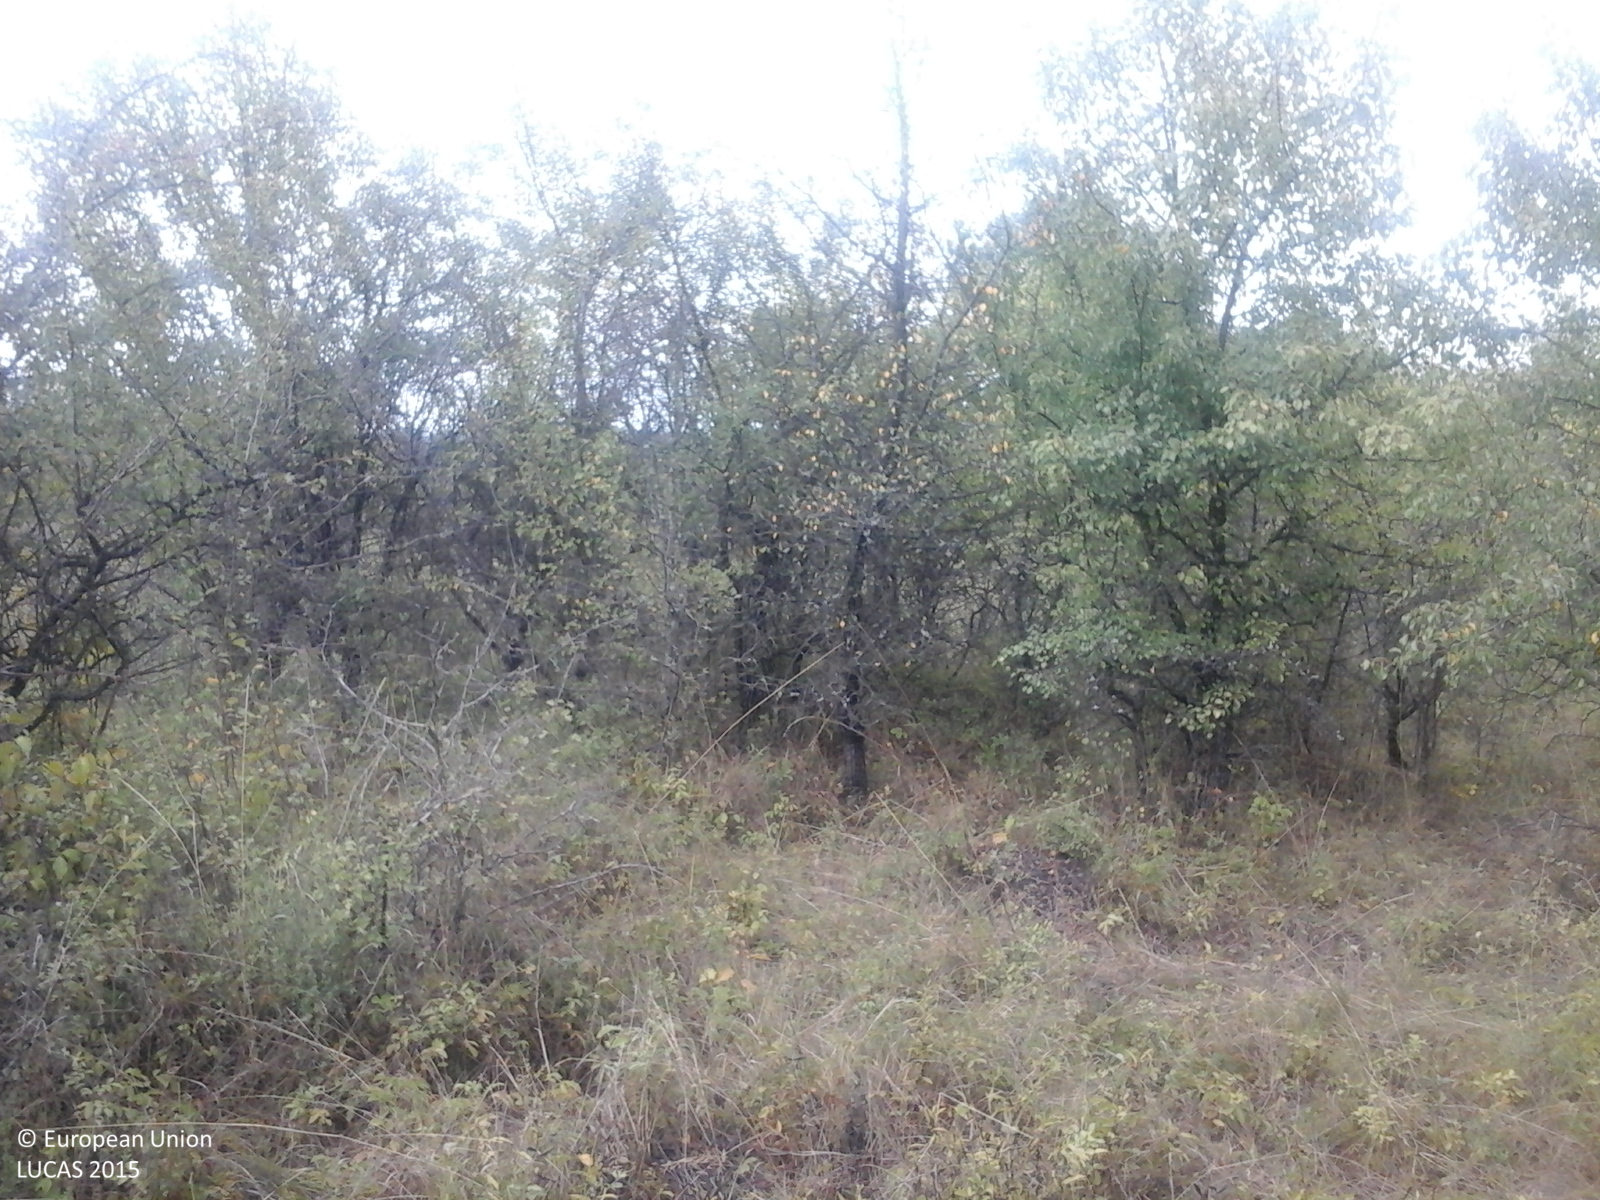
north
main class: Shrubland
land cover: Shrubland with sparse tree cover
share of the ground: 25 - 50 %
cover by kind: herbaceous plants 60 %, shrubs 35 %, broadleaved forest trees 5 %
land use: Abandoned areas
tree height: < 5 m
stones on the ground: < 10 %
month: August
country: RO
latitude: 45.8971
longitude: 21.6229
